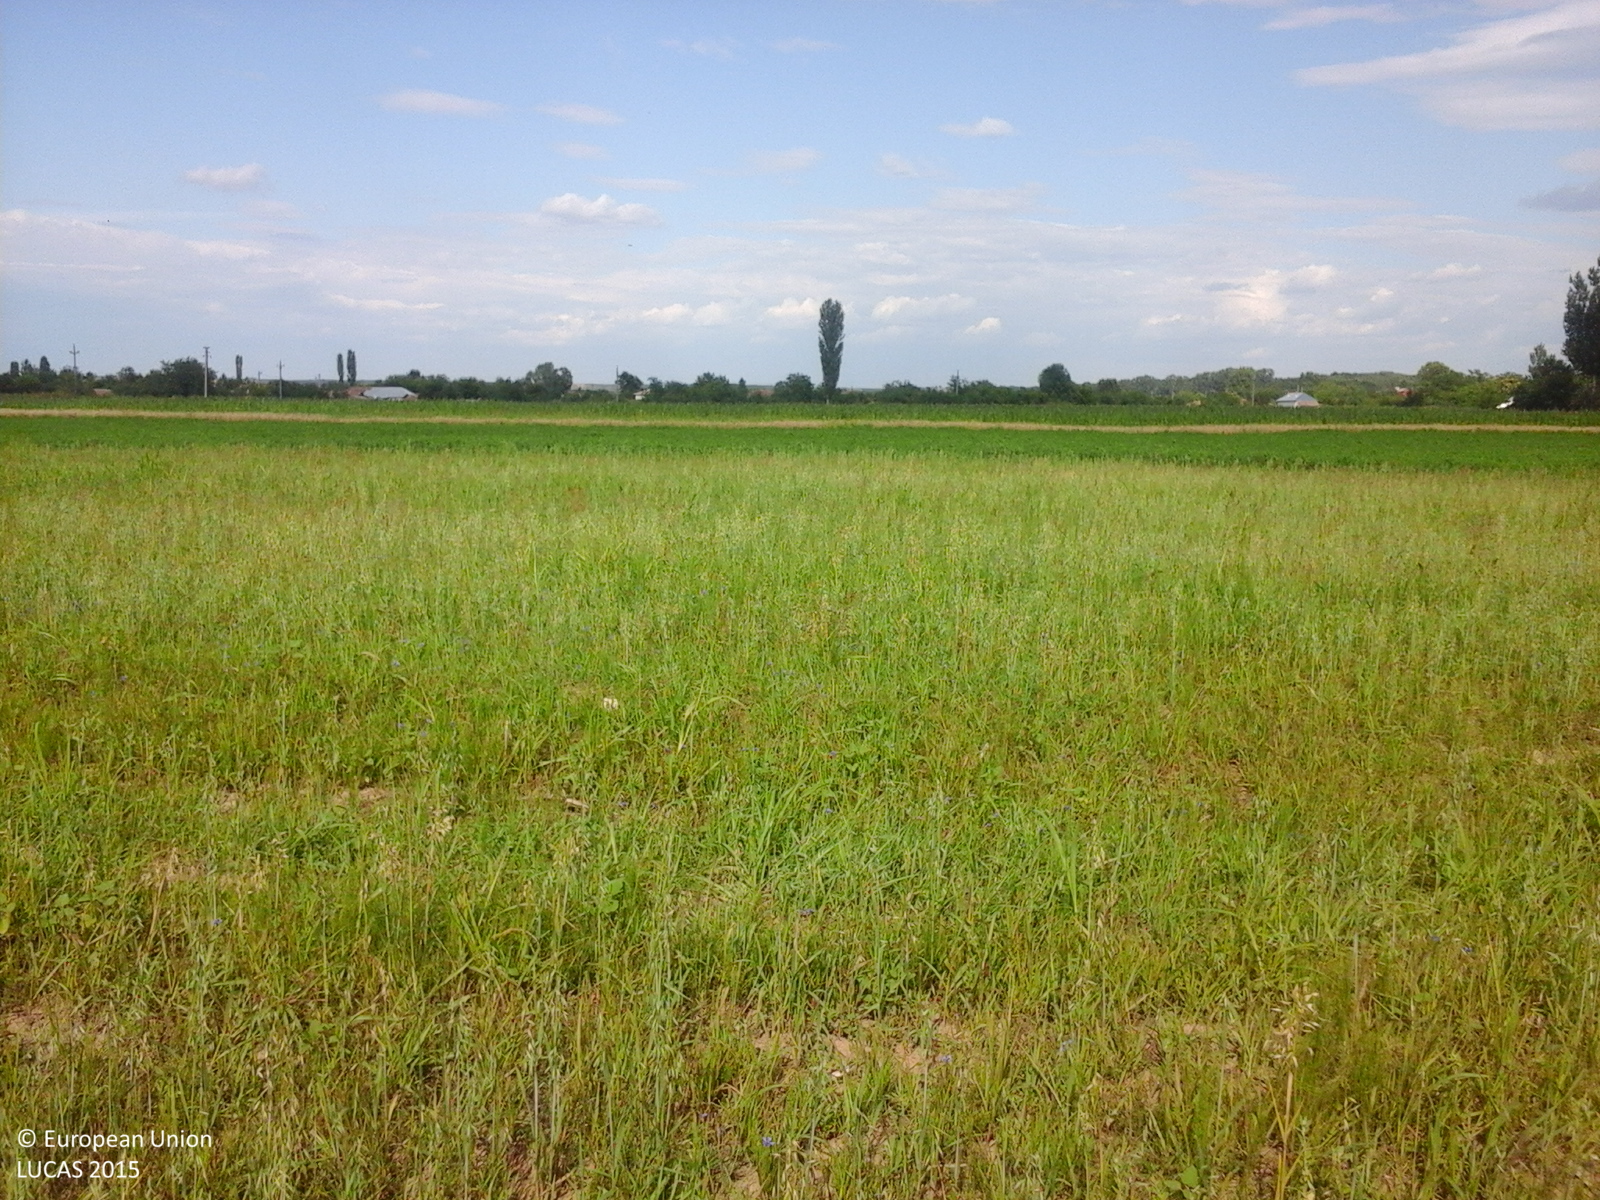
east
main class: Grassland
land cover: Grassland without tree/shrub cover
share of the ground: > 75 %
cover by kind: herbaceous plants 100 %
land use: Agriculture (excluding fallow land and kitchen gardens)
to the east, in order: Grassland without tree/shrub cover; Oats; Lucerne; Rye; Lucerne; Maize; Lucerne; Maize
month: July
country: RO
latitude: 44.0460
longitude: 24.5833
